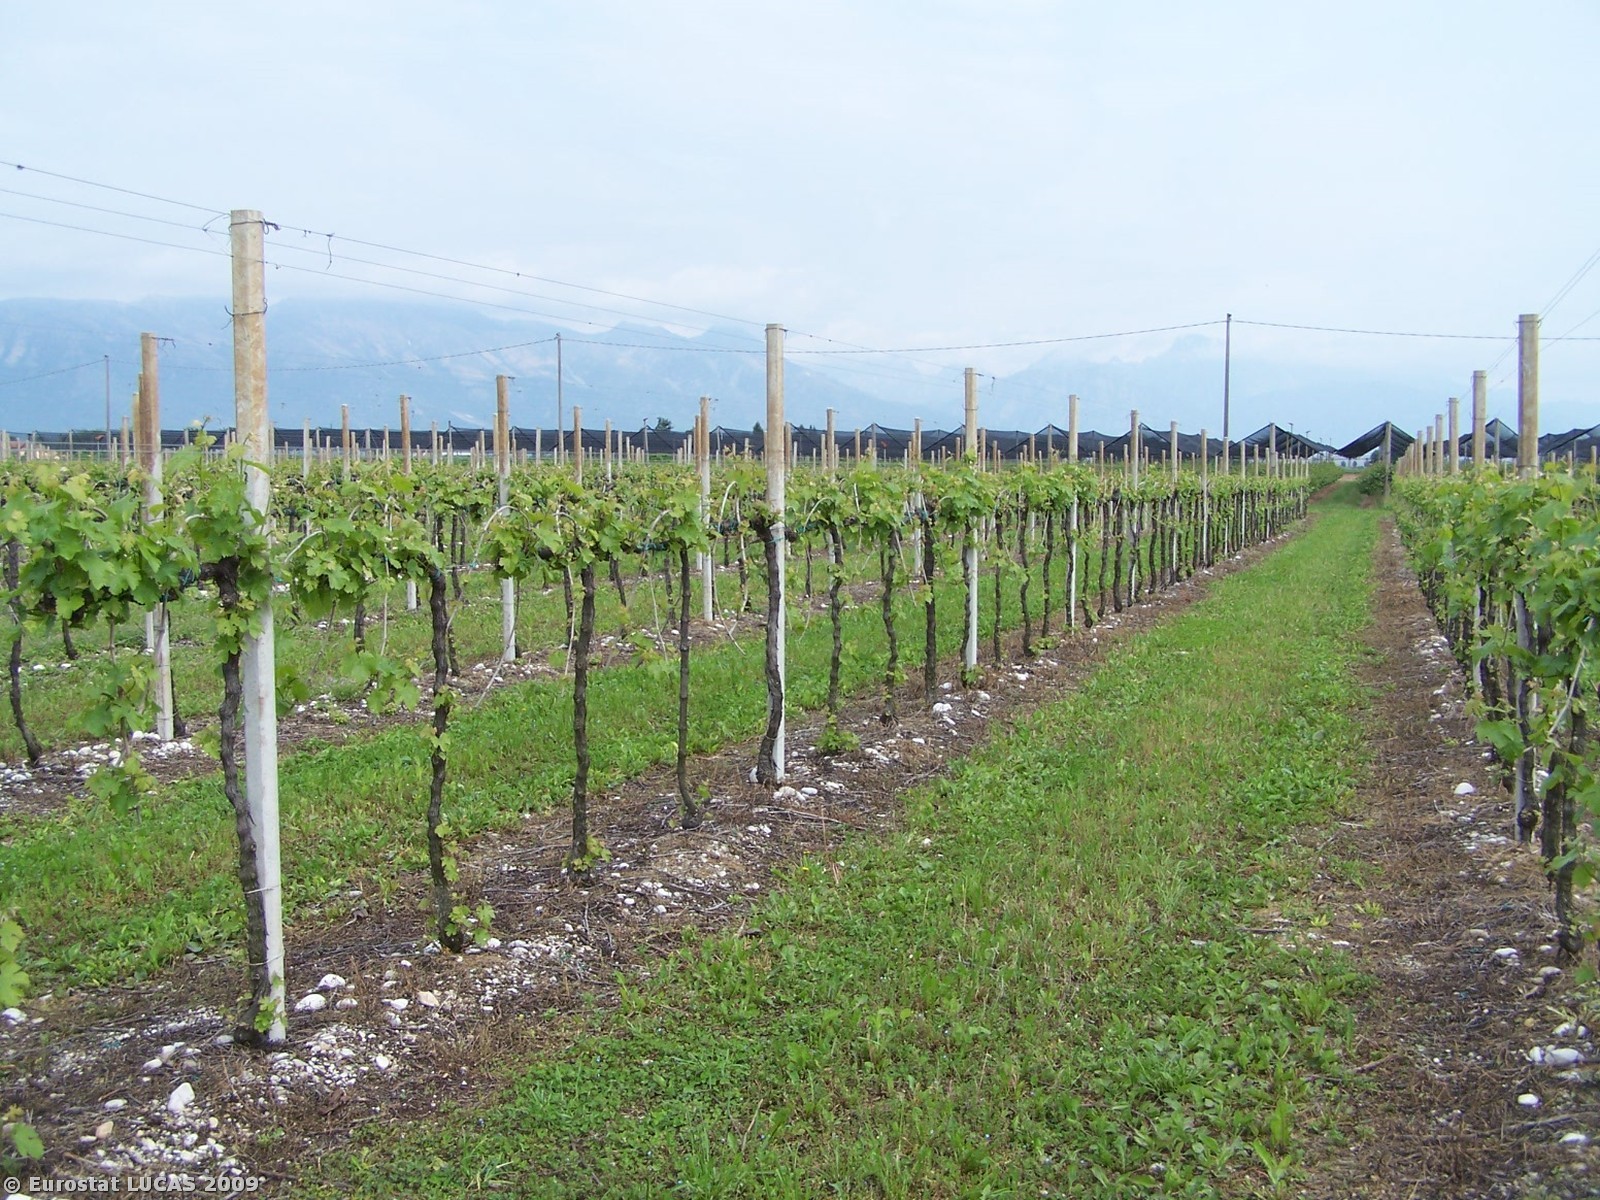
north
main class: Cropland
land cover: Vineyards
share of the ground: 10 - 25 %
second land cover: Grassland with sparse tree/shrub cover
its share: 50 - 75 %
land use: Agriculture (excluding fallow land and kitchen gardens)
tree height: < 5 m
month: May
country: IT
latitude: 46.0121
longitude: 12.6443
